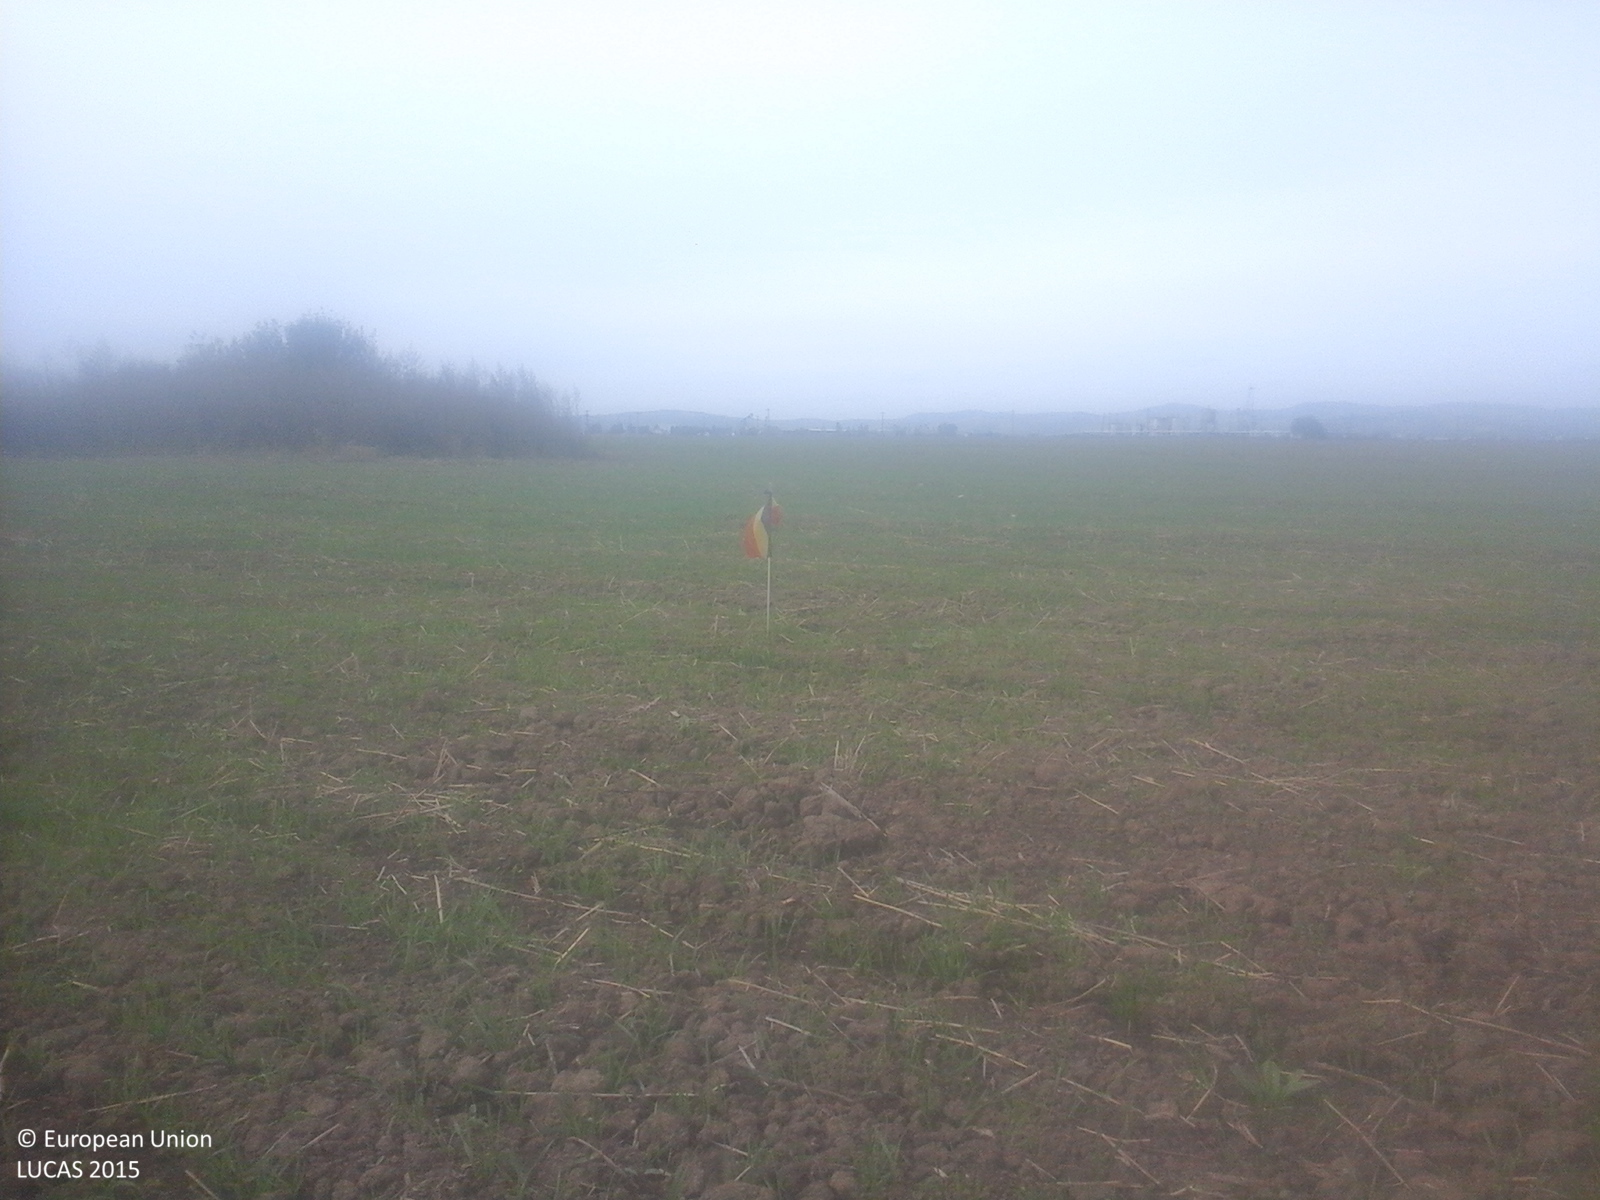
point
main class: Cropland
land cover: Common wheat
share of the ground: 10 - 25 %
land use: Agriculture (excluding fallow land and kitchen gardens)
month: October
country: RO
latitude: 44.9502
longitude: 25.7814
